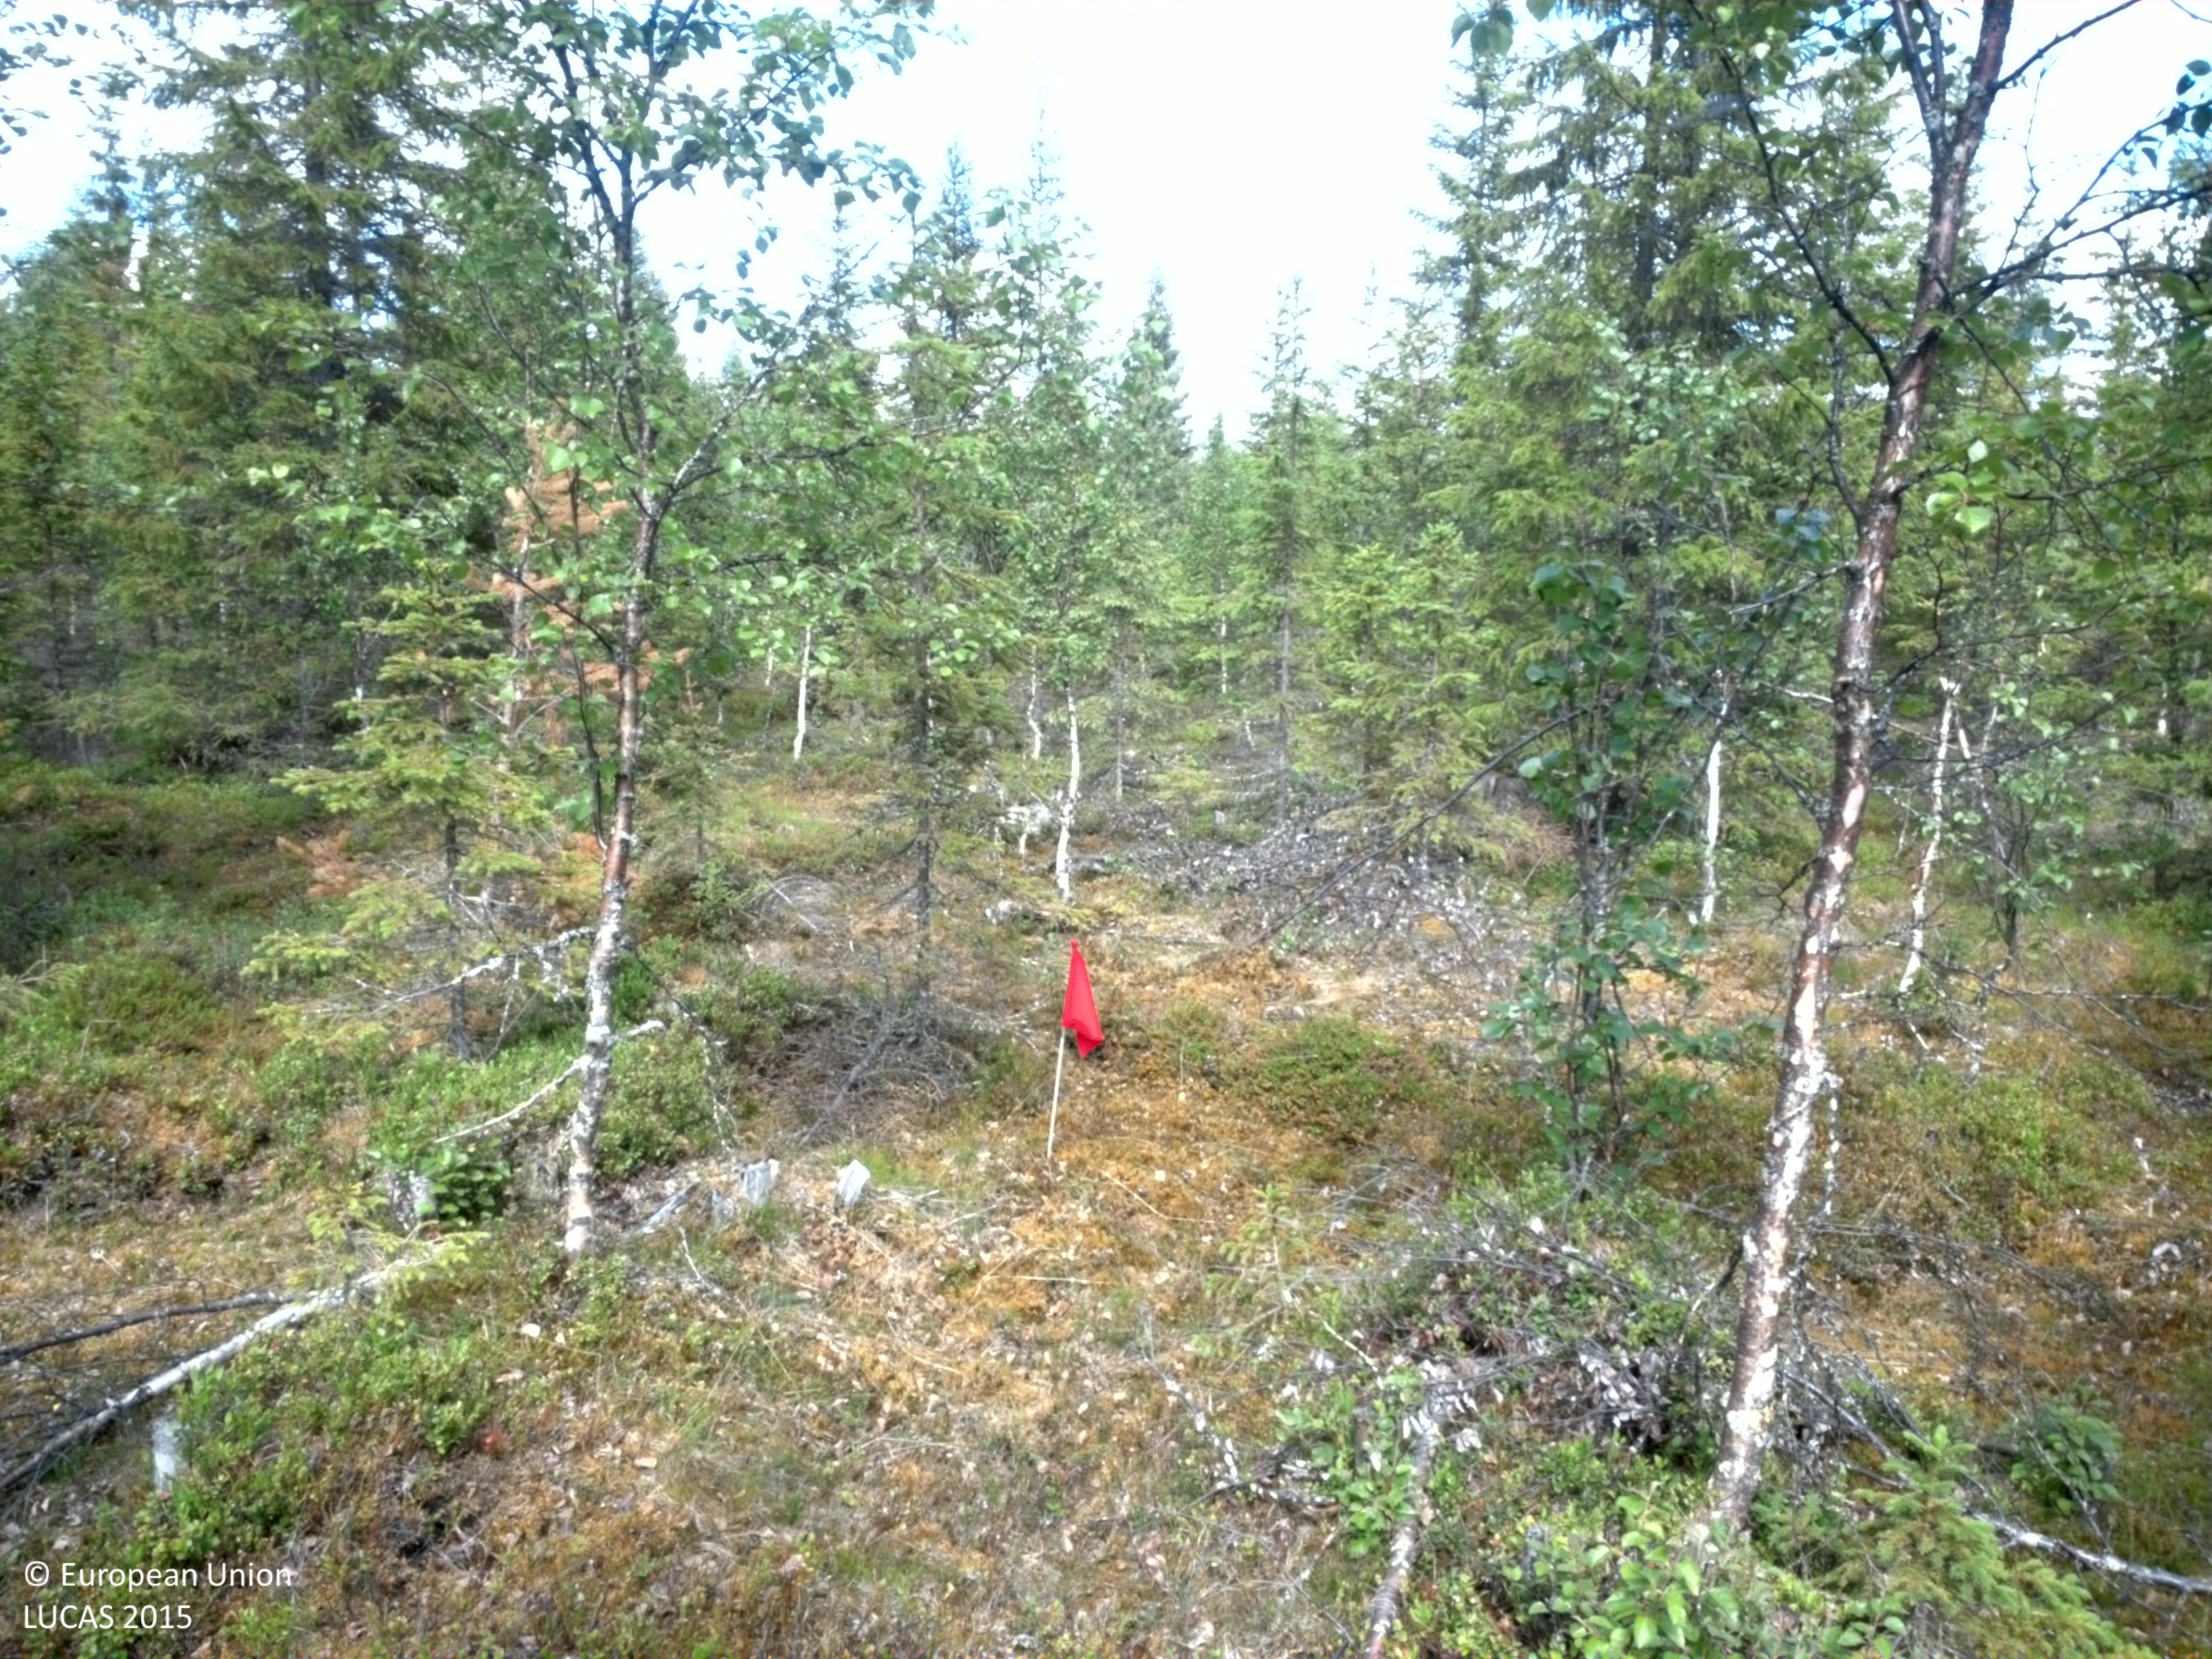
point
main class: Woodland
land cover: Spruce dominated mixed woodland
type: boreal forest
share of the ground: 25 - 50 %
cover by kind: coniferous forest trees 30 %, shrubs 25 %, lichens and mosses 25 %, broadleaved forest trees 10 %, herbaceous plants 10 %
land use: Forestry
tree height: < 5 m
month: July
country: SE
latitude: 64.4912
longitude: 18.2719
